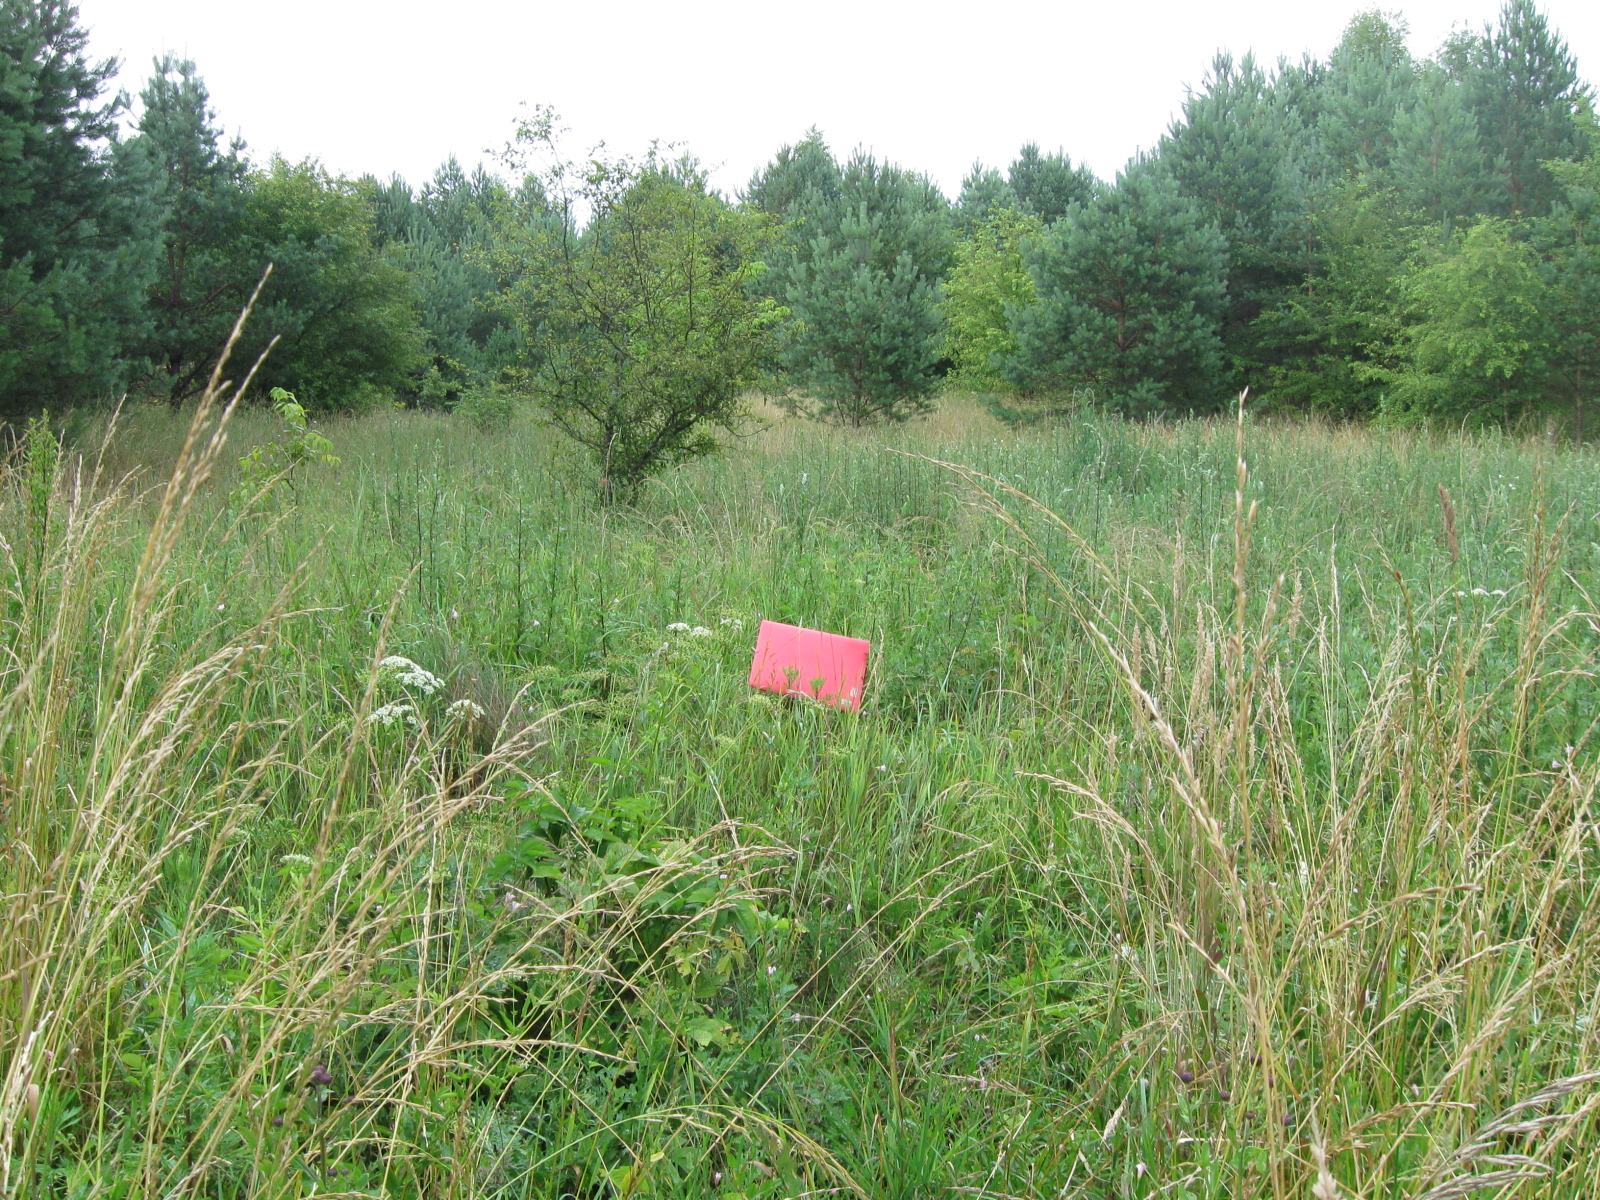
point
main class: Grassland
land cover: Grassland with sparse tree/shrub cover
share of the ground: > 75 %
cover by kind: herbaceous plants 90 %, broadleaved forest trees 5 %, shrubs 5 %
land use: Forestry
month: July
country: LT
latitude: 54.0320
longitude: 23.6275
